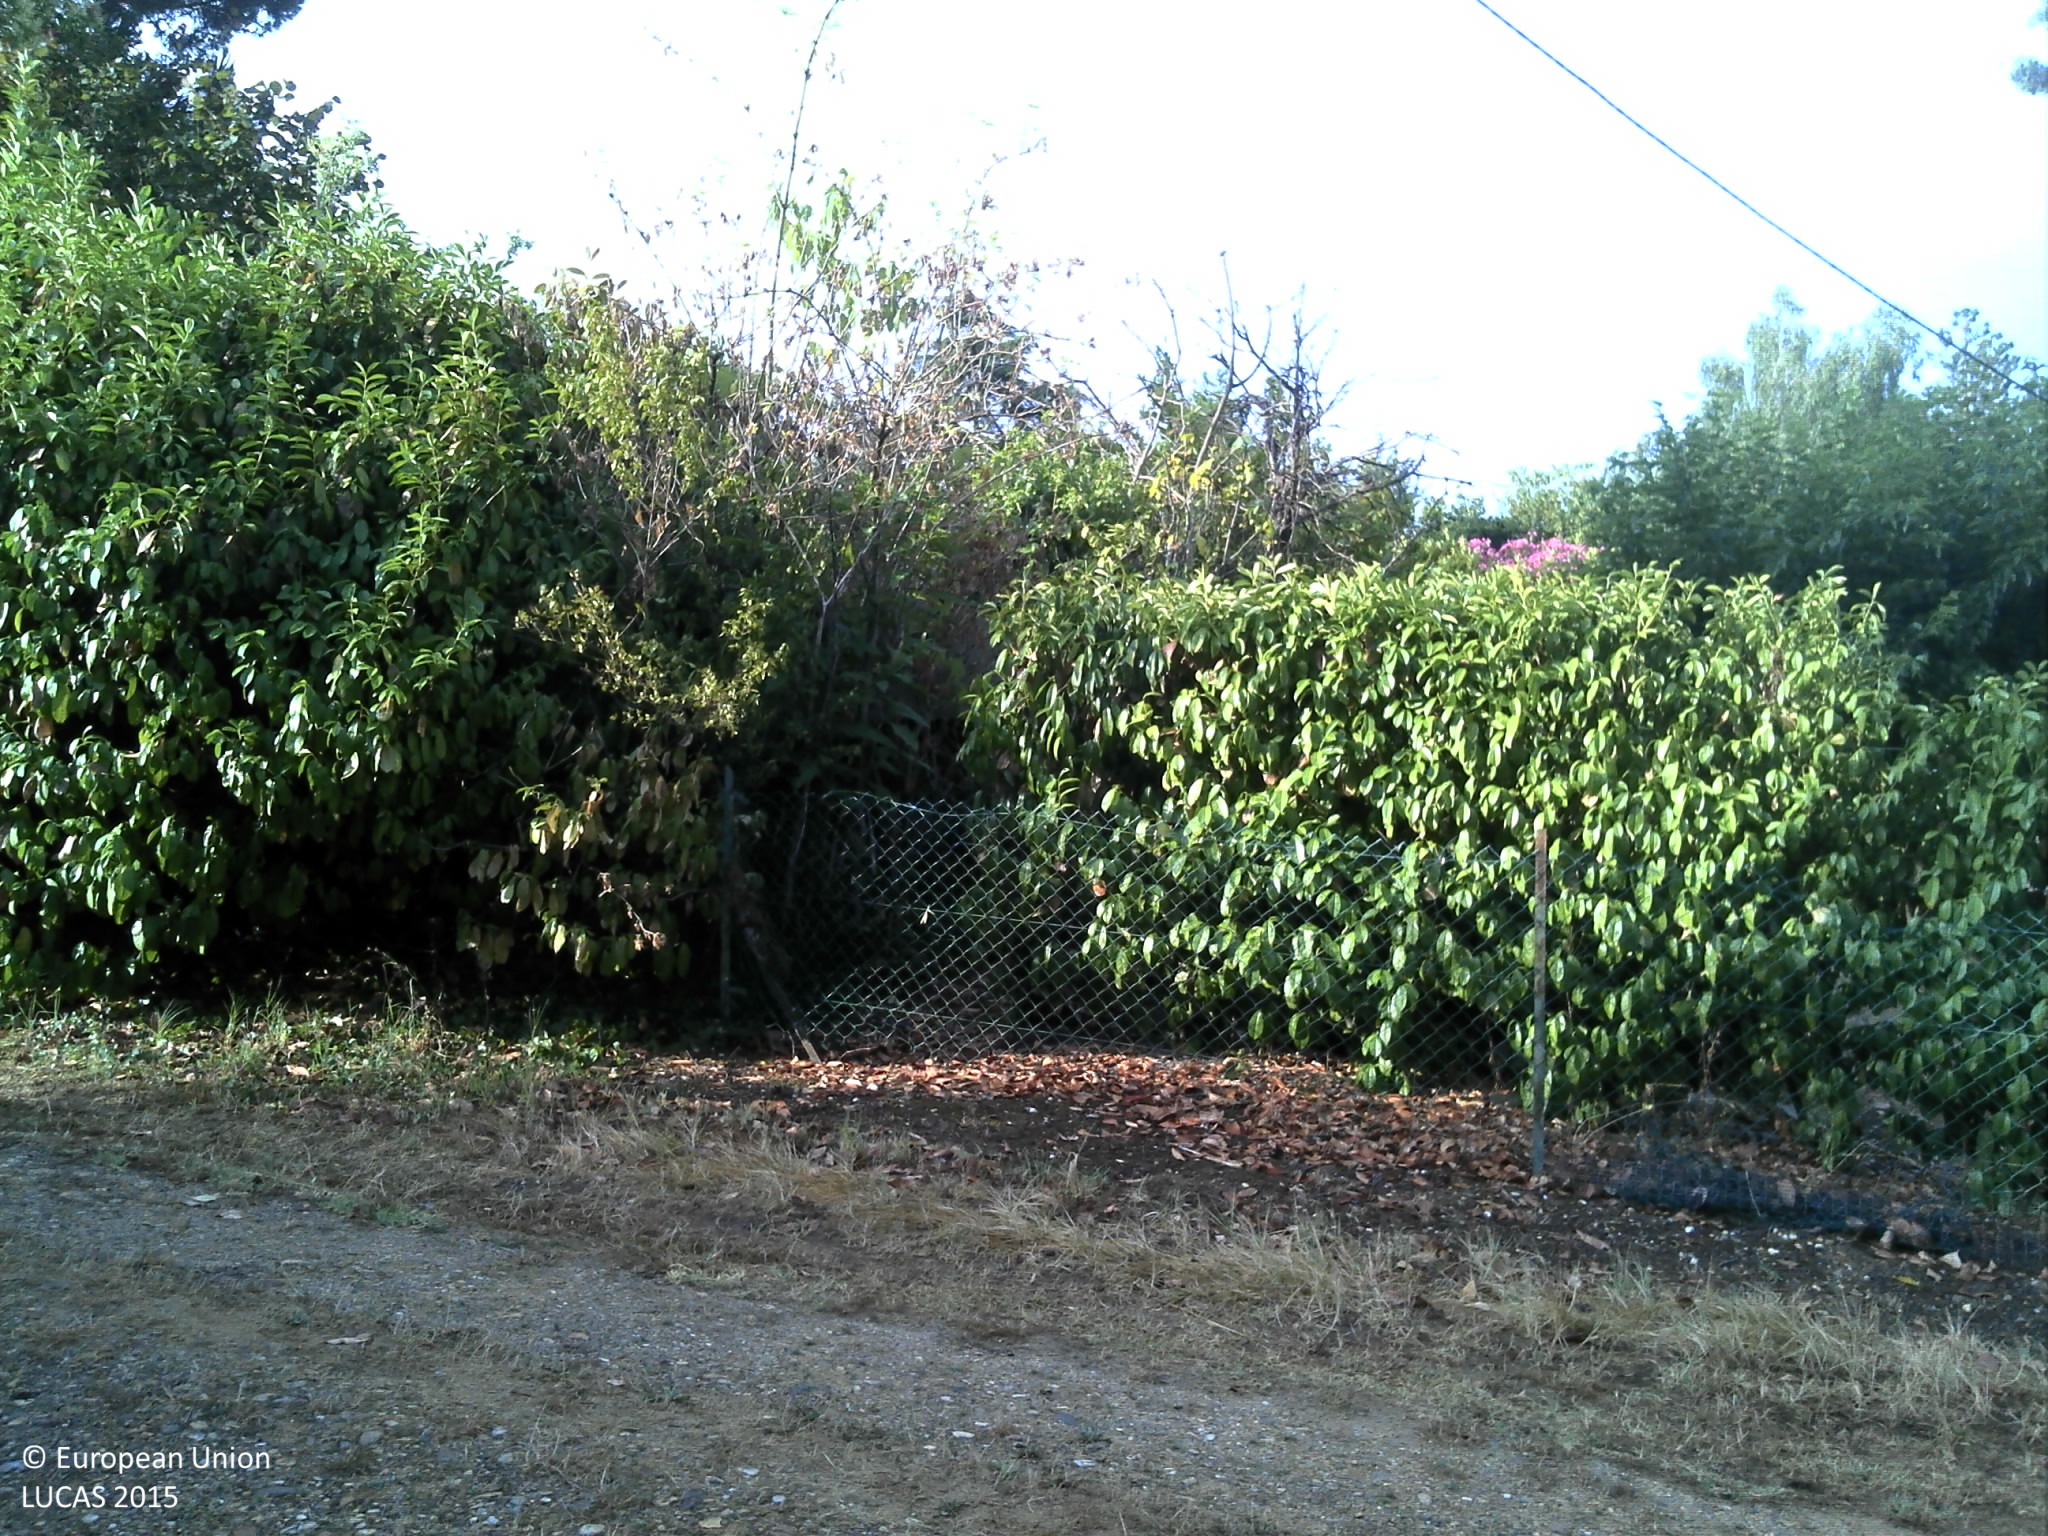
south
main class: Woodland
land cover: Other mixed woodland
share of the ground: > 75 %
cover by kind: coniferous forest trees 30 %, broadleaved forest trees 30 %, shrubs 30 %, herbaceous plants 10 %
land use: Residential
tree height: < 5 m
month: July
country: FR
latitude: 44.7343
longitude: -0.5874
